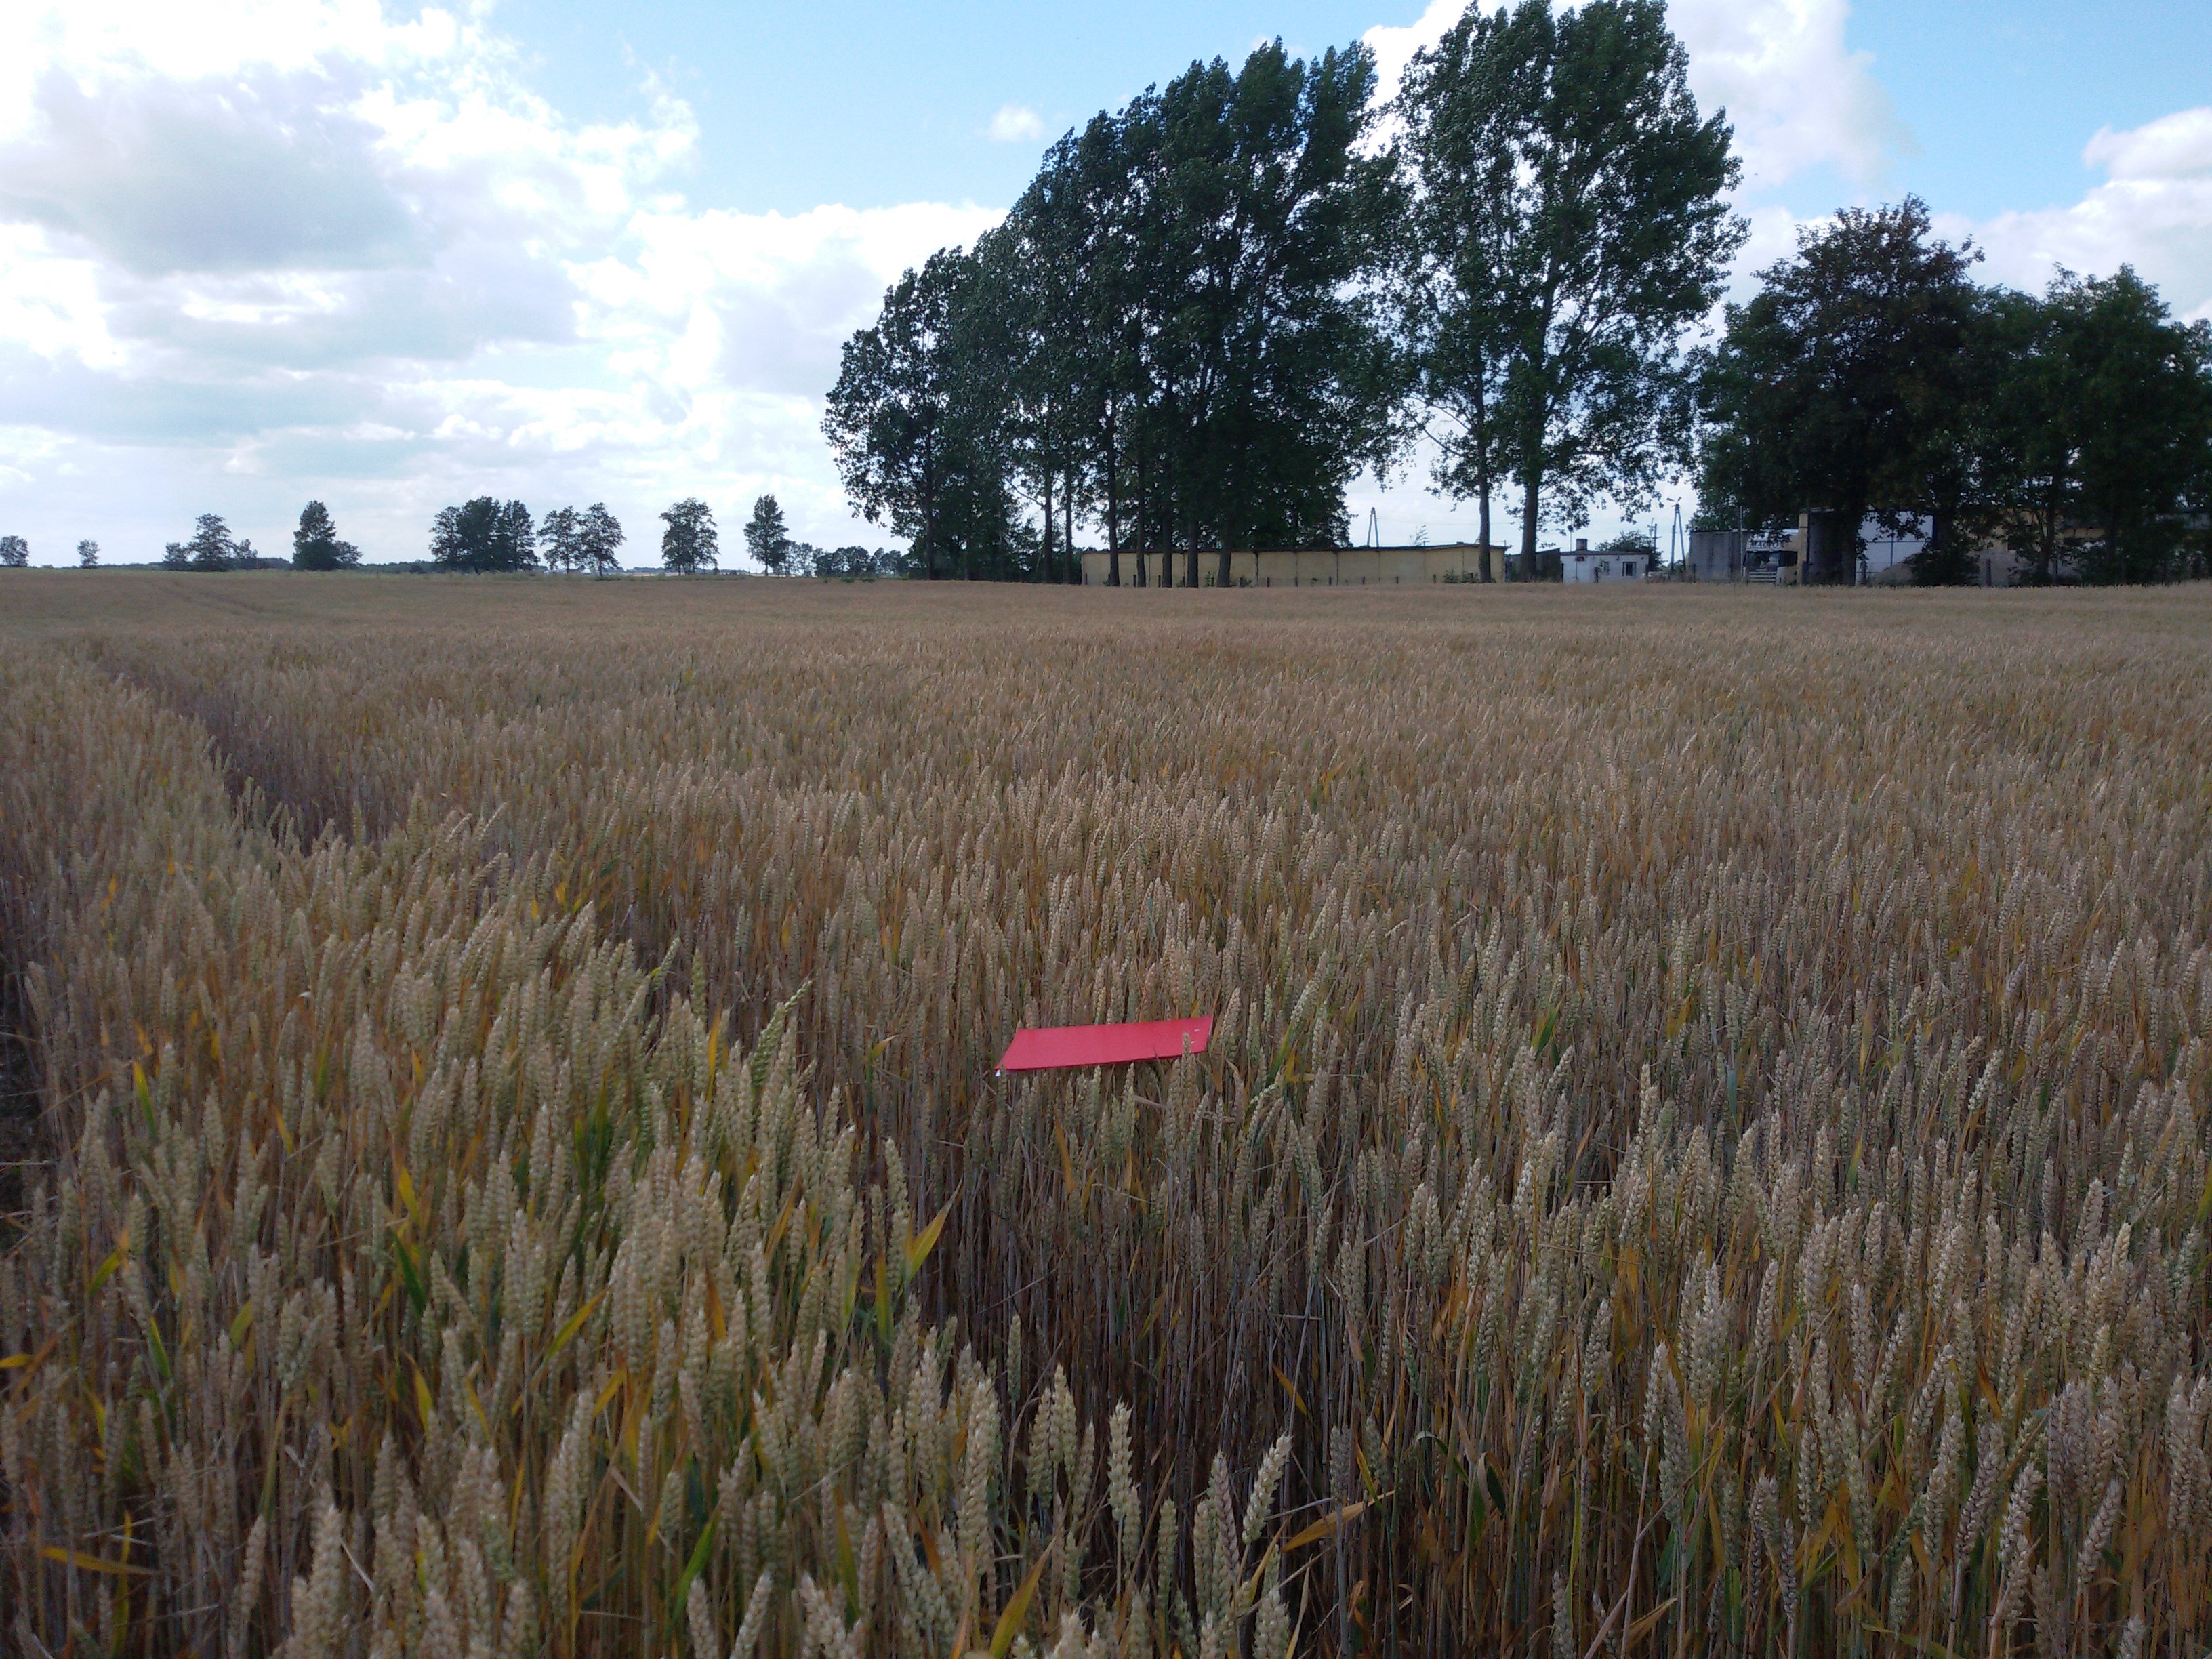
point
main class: Cropland
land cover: Common wheat
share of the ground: > 75 %
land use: Agriculture (excluding fallow land and kitchen gardens)
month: July
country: PL
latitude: 52.7863
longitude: 17.5598
